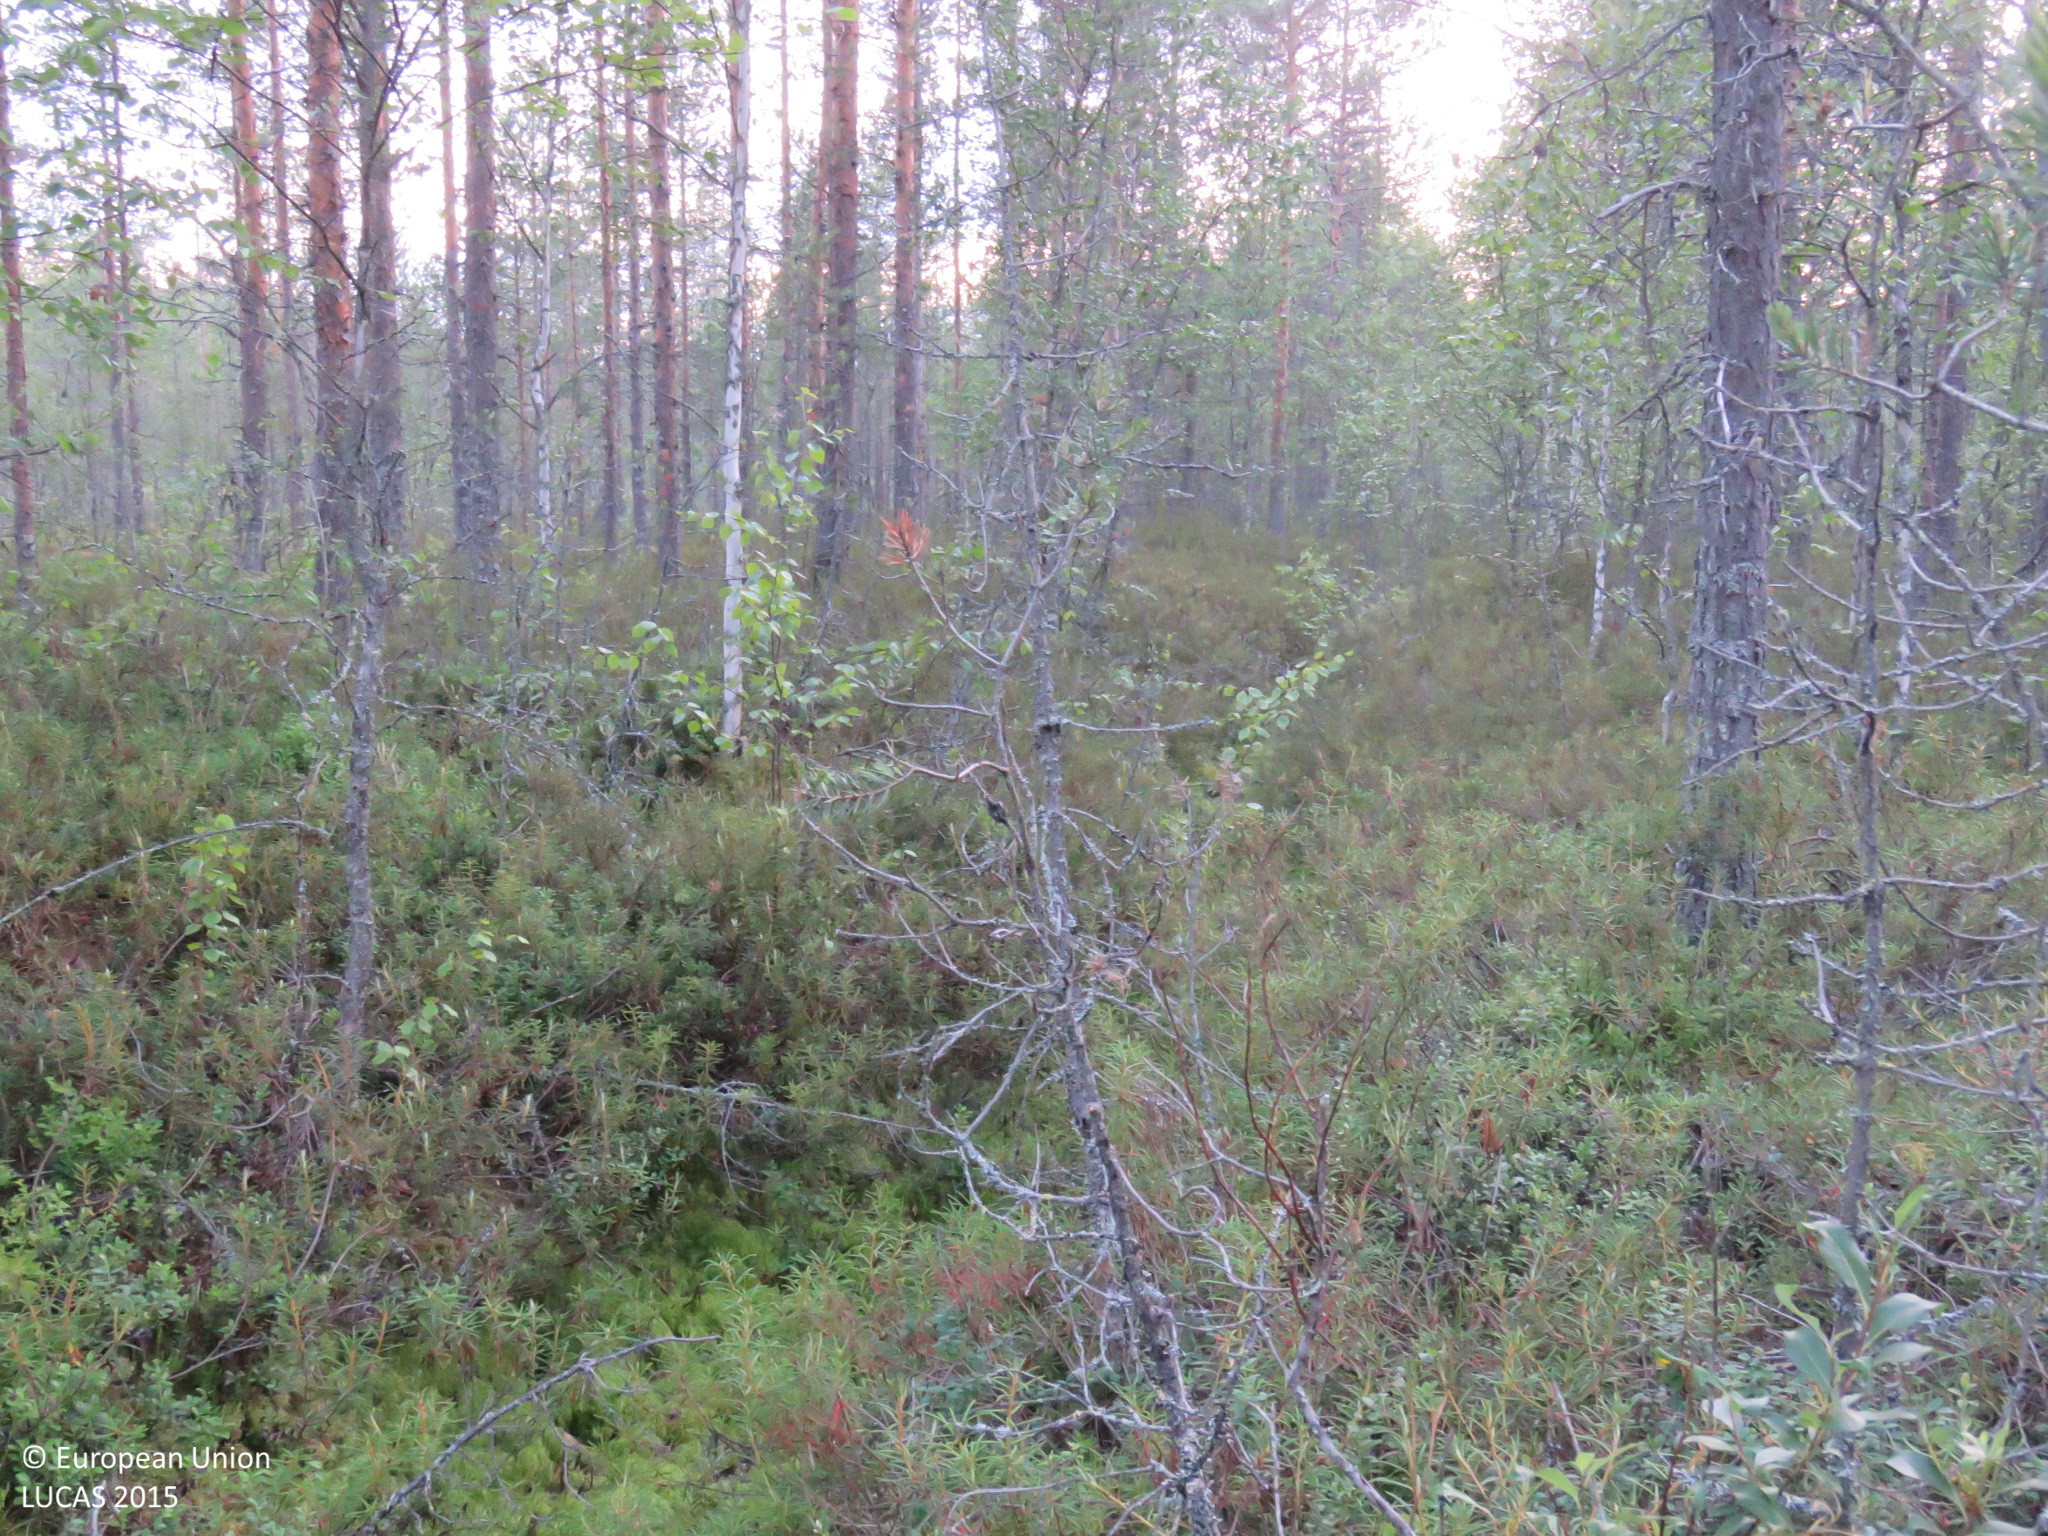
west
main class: Woodland
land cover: Pine dominated coniferous woodland
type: boreal forest
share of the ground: > 75 %
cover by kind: coniferous forest trees 80 %, broadleaved forest trees 10 %, shrubs 10 %
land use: Forestry
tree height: > 5 m
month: July
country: FI
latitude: 64.7684
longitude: 26.3165
